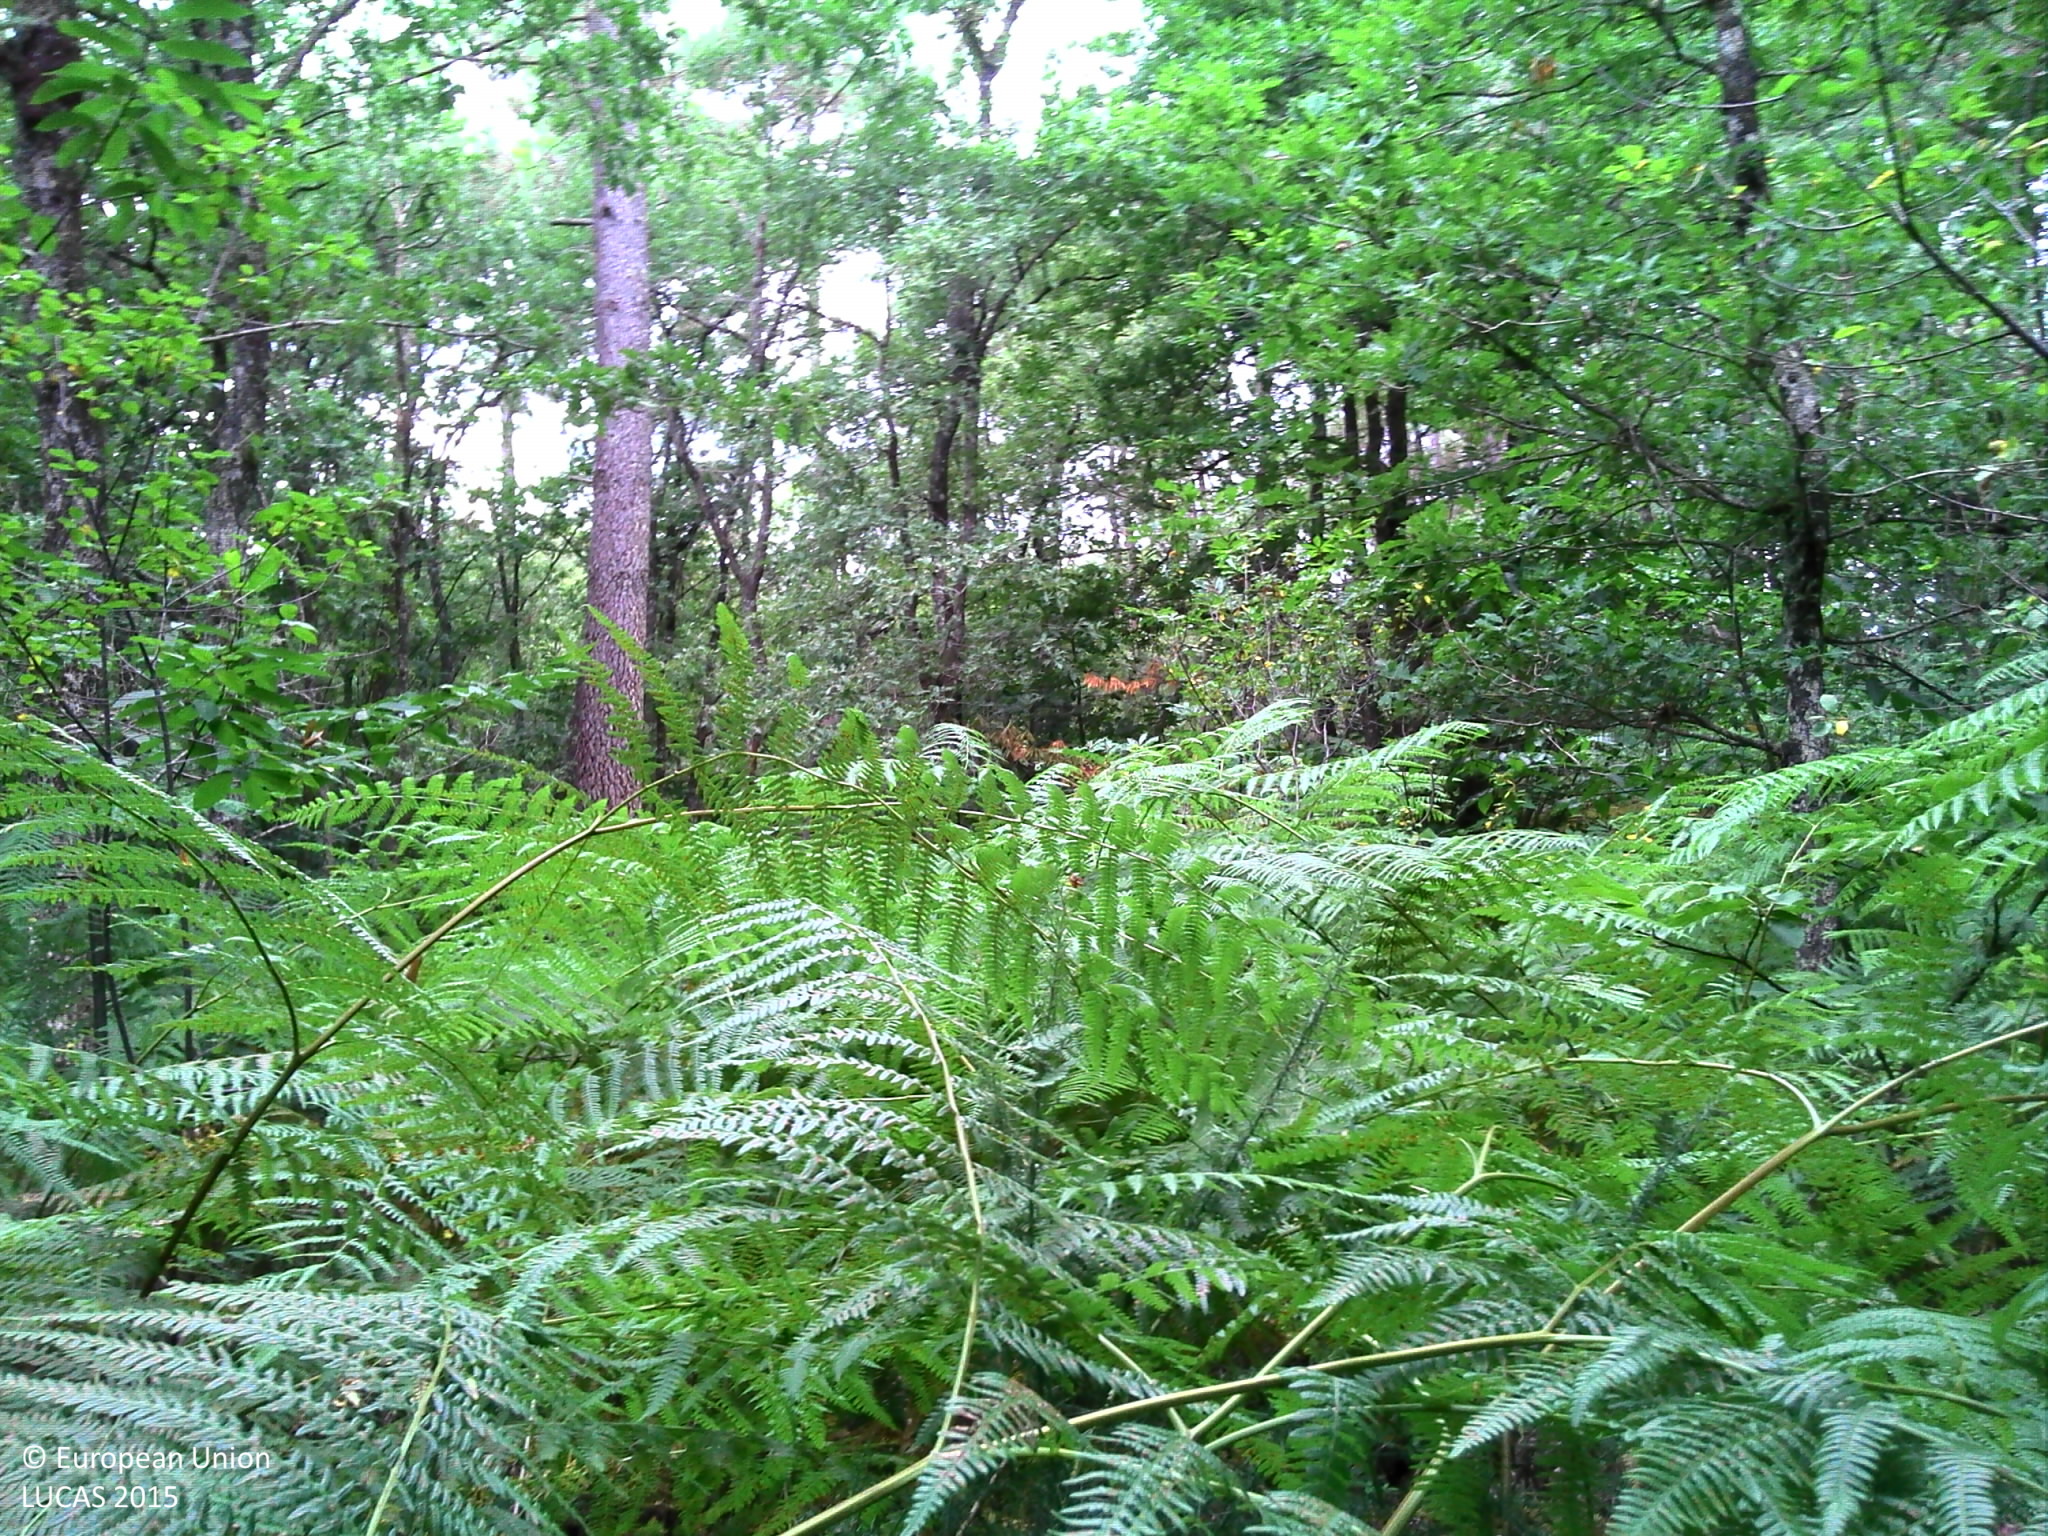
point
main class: Woodland
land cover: Broadleaved woodland
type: acidophilous oak and oak-birch forest
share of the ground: 50 - 75 %
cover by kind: broadleaved forest trees 75 %, herbaceous plants 15 %, shrubs 5 %, lichens and mosses 5 %
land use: Forestry
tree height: > 5 m
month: July
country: FR
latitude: 45.0821
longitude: 0.7807
